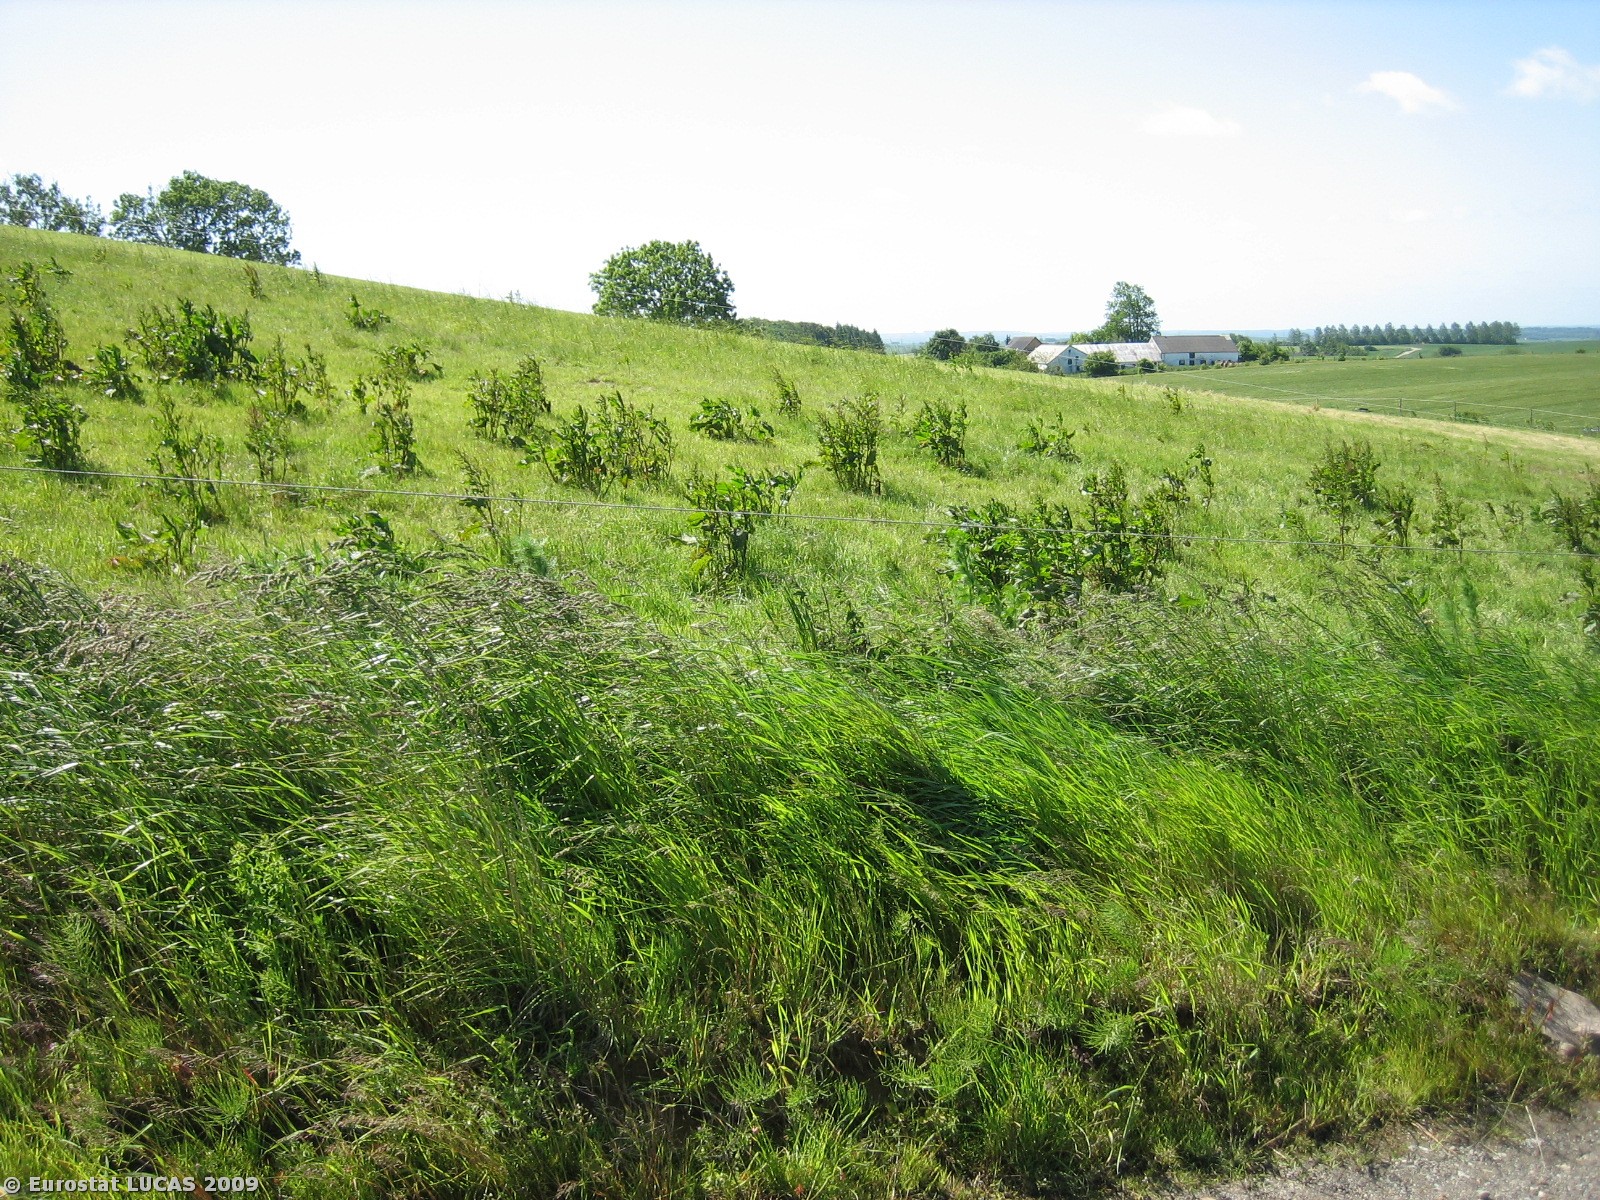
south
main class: Grassland
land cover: Grassland without tree/shrub cover
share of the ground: > 75 %
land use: Agriculture (excluding fallow land and kitchen gardens)
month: June
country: DK
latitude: 55.9720
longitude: 9.9200
